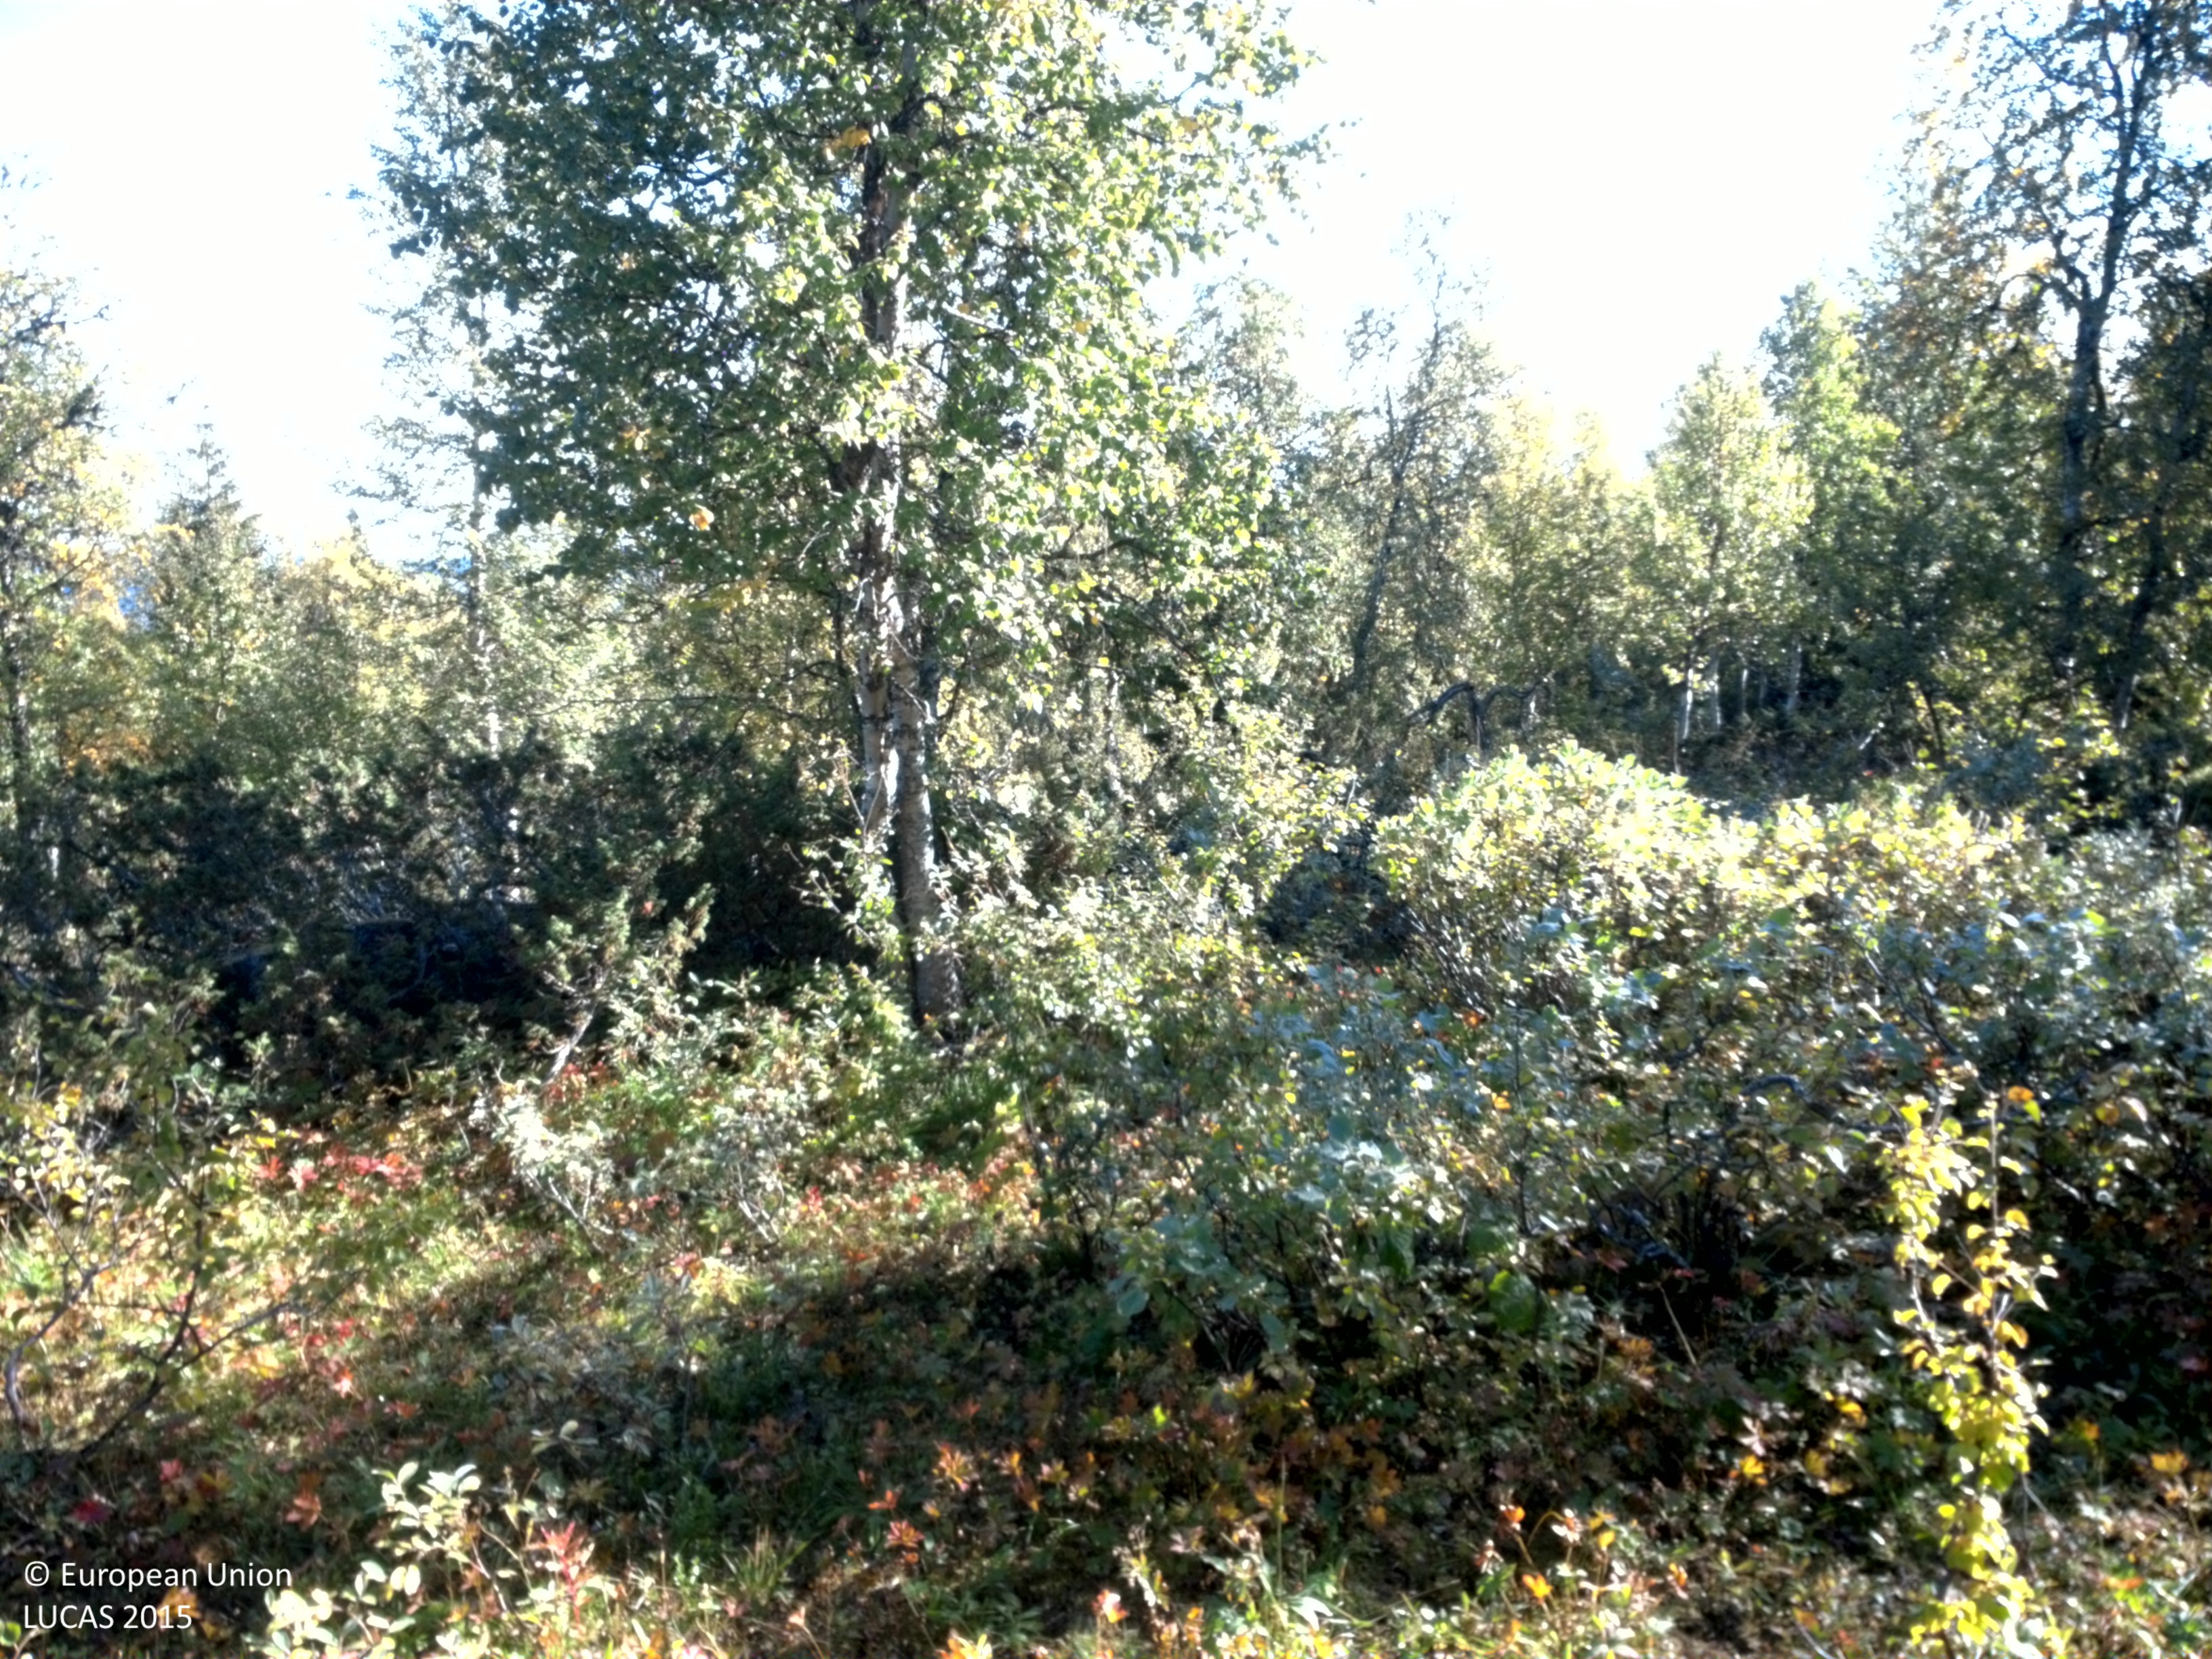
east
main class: Woodland
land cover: Broadleaved woodland
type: non-riverine alder, birch or aspen forest
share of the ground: 10 - 25 %
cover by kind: shrubs 50 %, herbaceous plants 30 %, broadleaved forest trees 15 %, lichens and mosses 5 %
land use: Amenities, museums, leisure
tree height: > 5 m
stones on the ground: < 10 %
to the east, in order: Broadleaved woodland; Spruce dominated mixed woodland
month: September
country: SE
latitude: 65.8461
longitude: 16.4202
